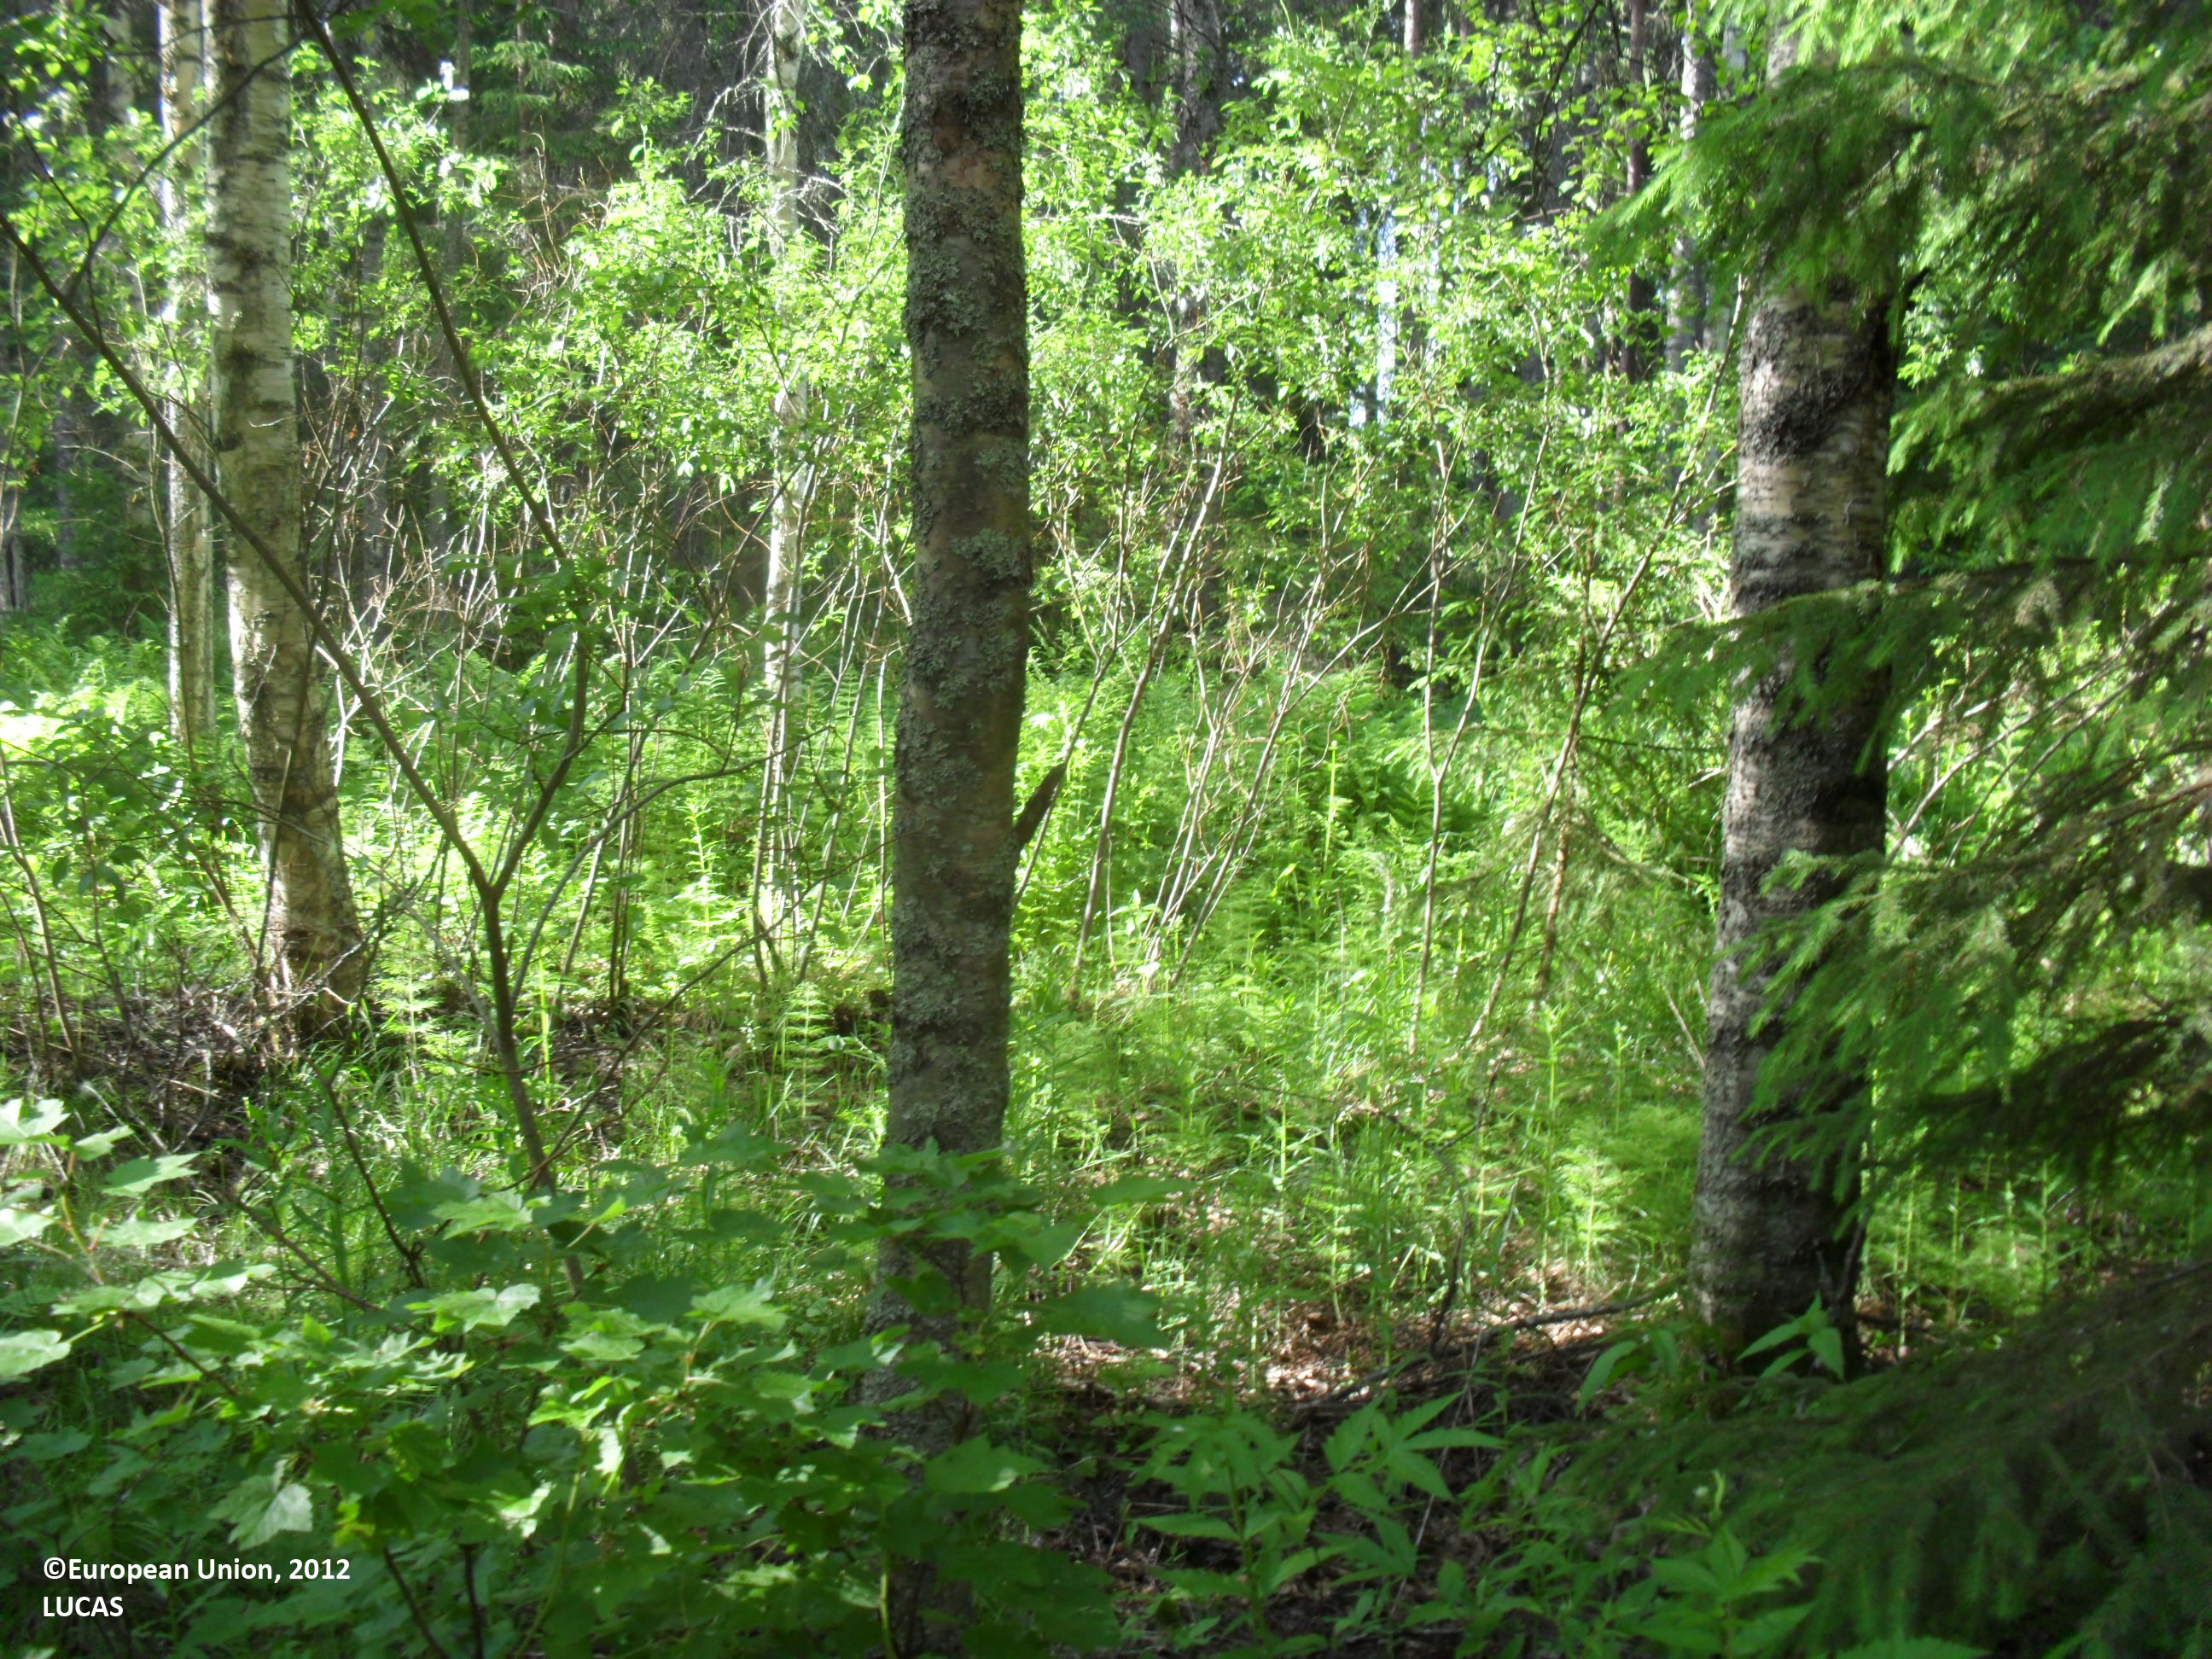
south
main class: Woodland
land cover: Broadleaved woodland
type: boreal forest
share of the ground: 50 - 75 %
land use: Forestry
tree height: > 5 m
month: June
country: FI
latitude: 63.1298
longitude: 22.9675
